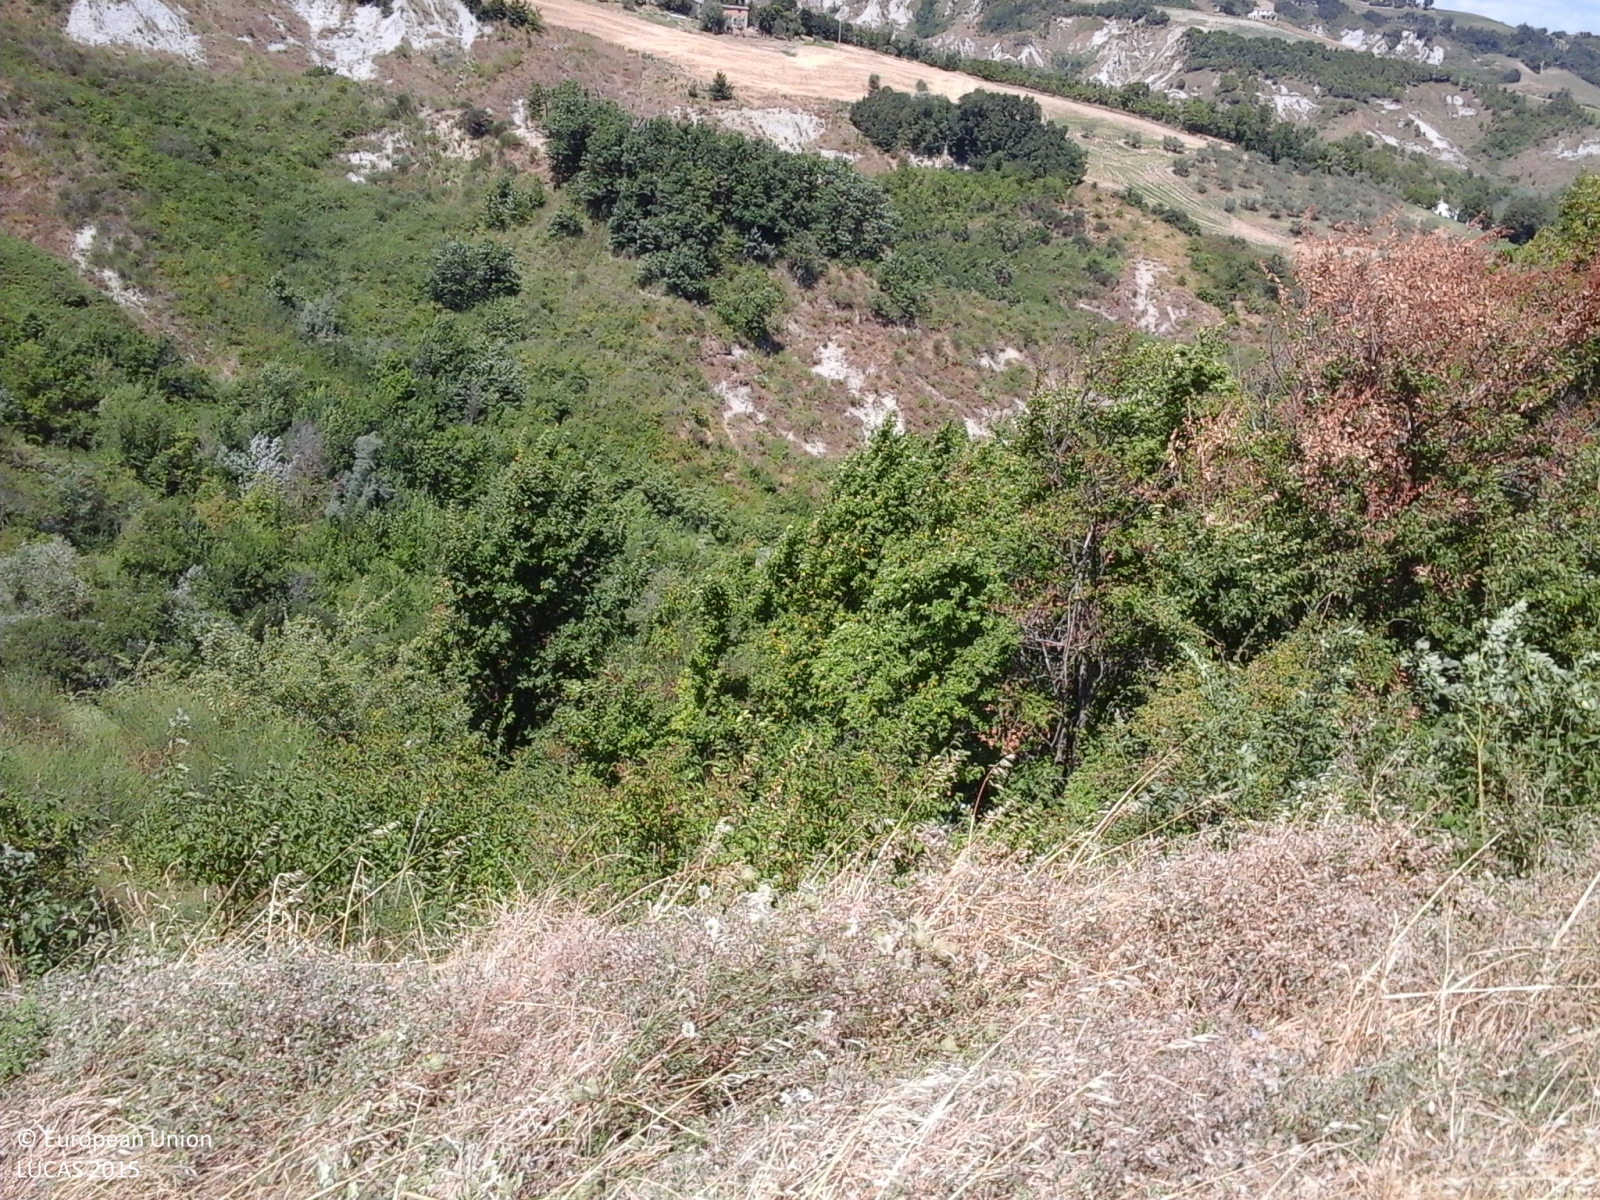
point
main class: Woodland
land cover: Broadleaved woodland
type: thermophilous deciduous forest
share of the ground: > 75 %
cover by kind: broadleaved forest trees 100 %
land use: Forestry
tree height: > 5 m
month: July
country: IT
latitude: 43.8303
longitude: 12.6176
